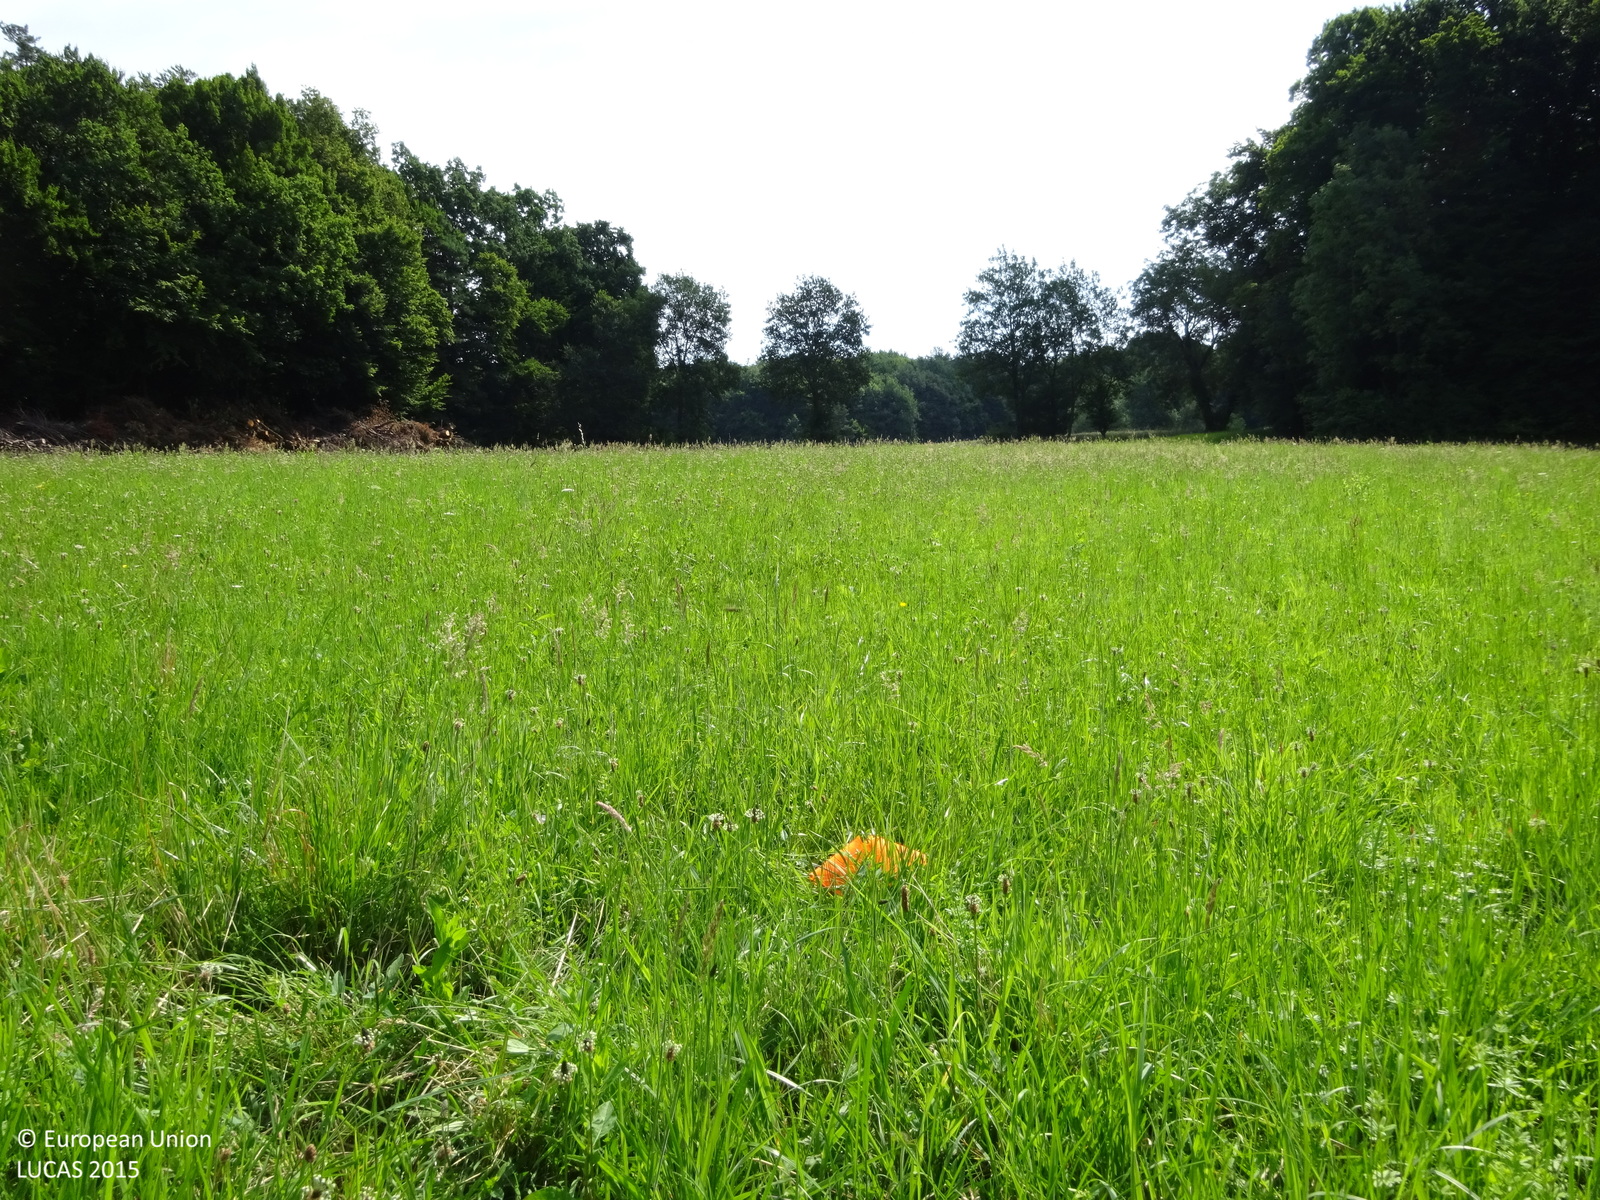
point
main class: Grassland
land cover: Grassland without tree/shrub cover
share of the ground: > 75 %
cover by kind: herbaceous plants 100 %
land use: Agriculture (excluding fallow land and kitchen gardens)
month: June
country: AT
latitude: 46.8376
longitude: 15.9137
